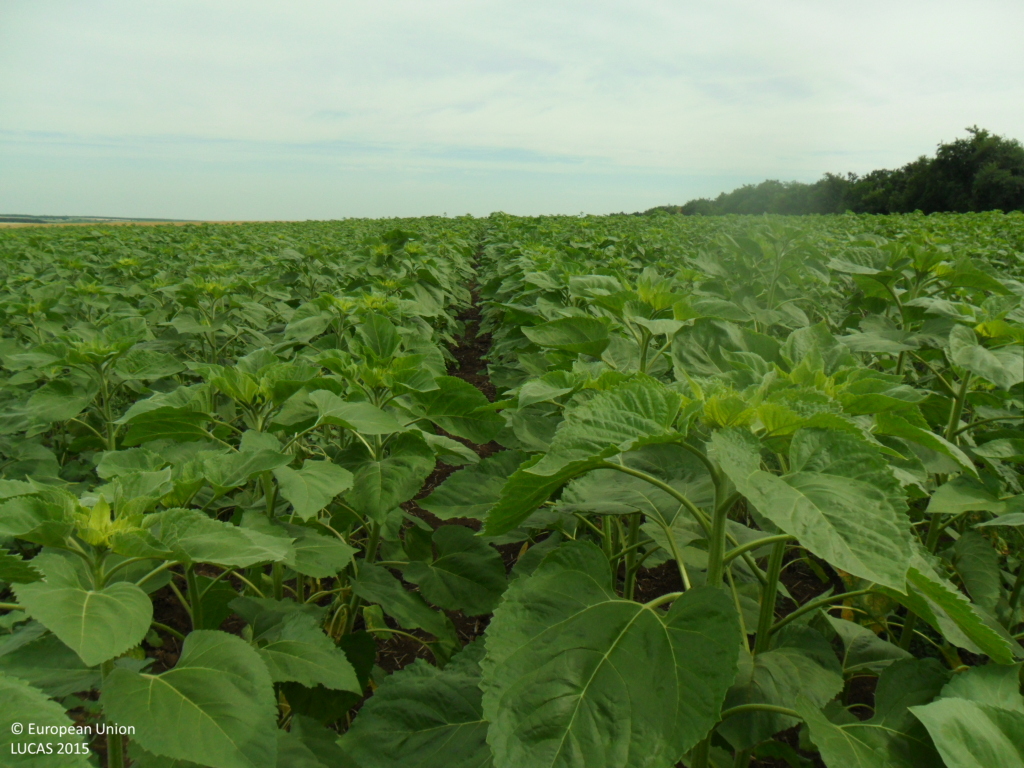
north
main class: Cropland
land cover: Sunflower
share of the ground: > 75 %
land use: Agriculture (excluding fallow land and kitchen gardens)
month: June
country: BG
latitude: 43.7105
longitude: 26.9857
